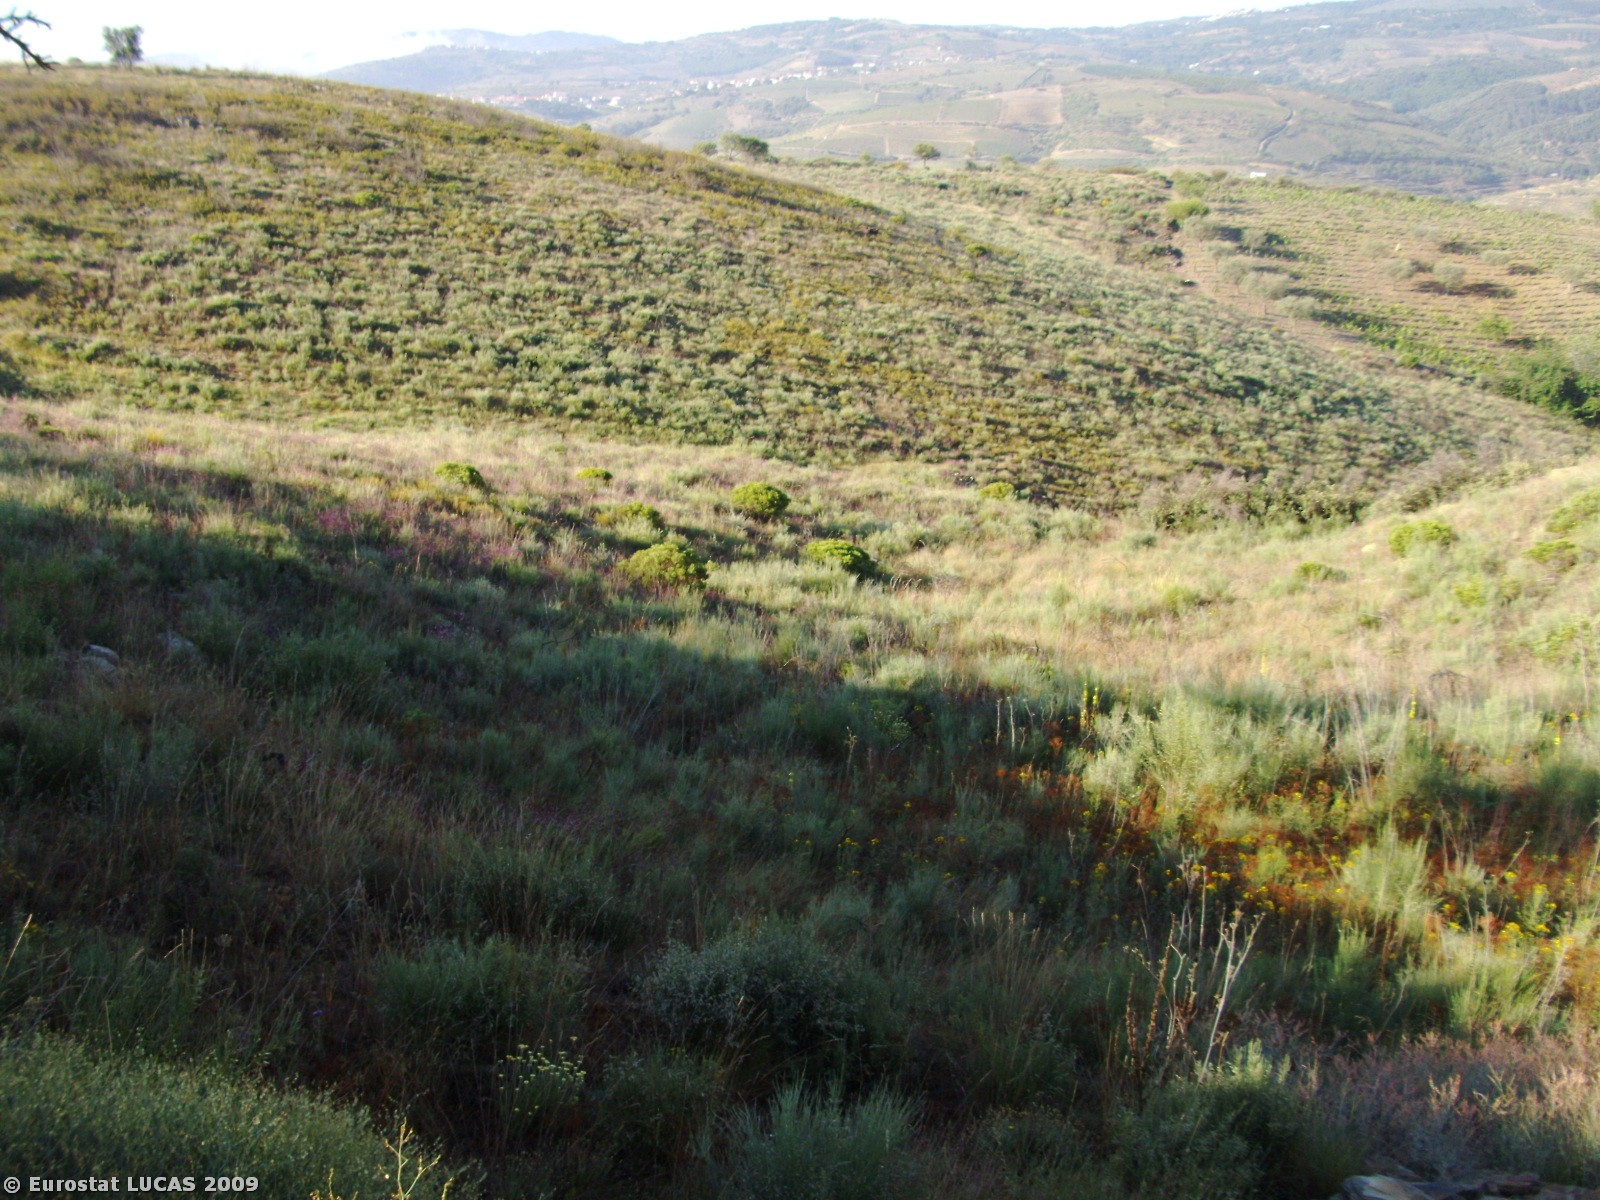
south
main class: Shrubland
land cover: Shrubland without tree cover
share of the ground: > 75 %
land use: Unused
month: May
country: PT
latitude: 41.0984
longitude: -7.3941
